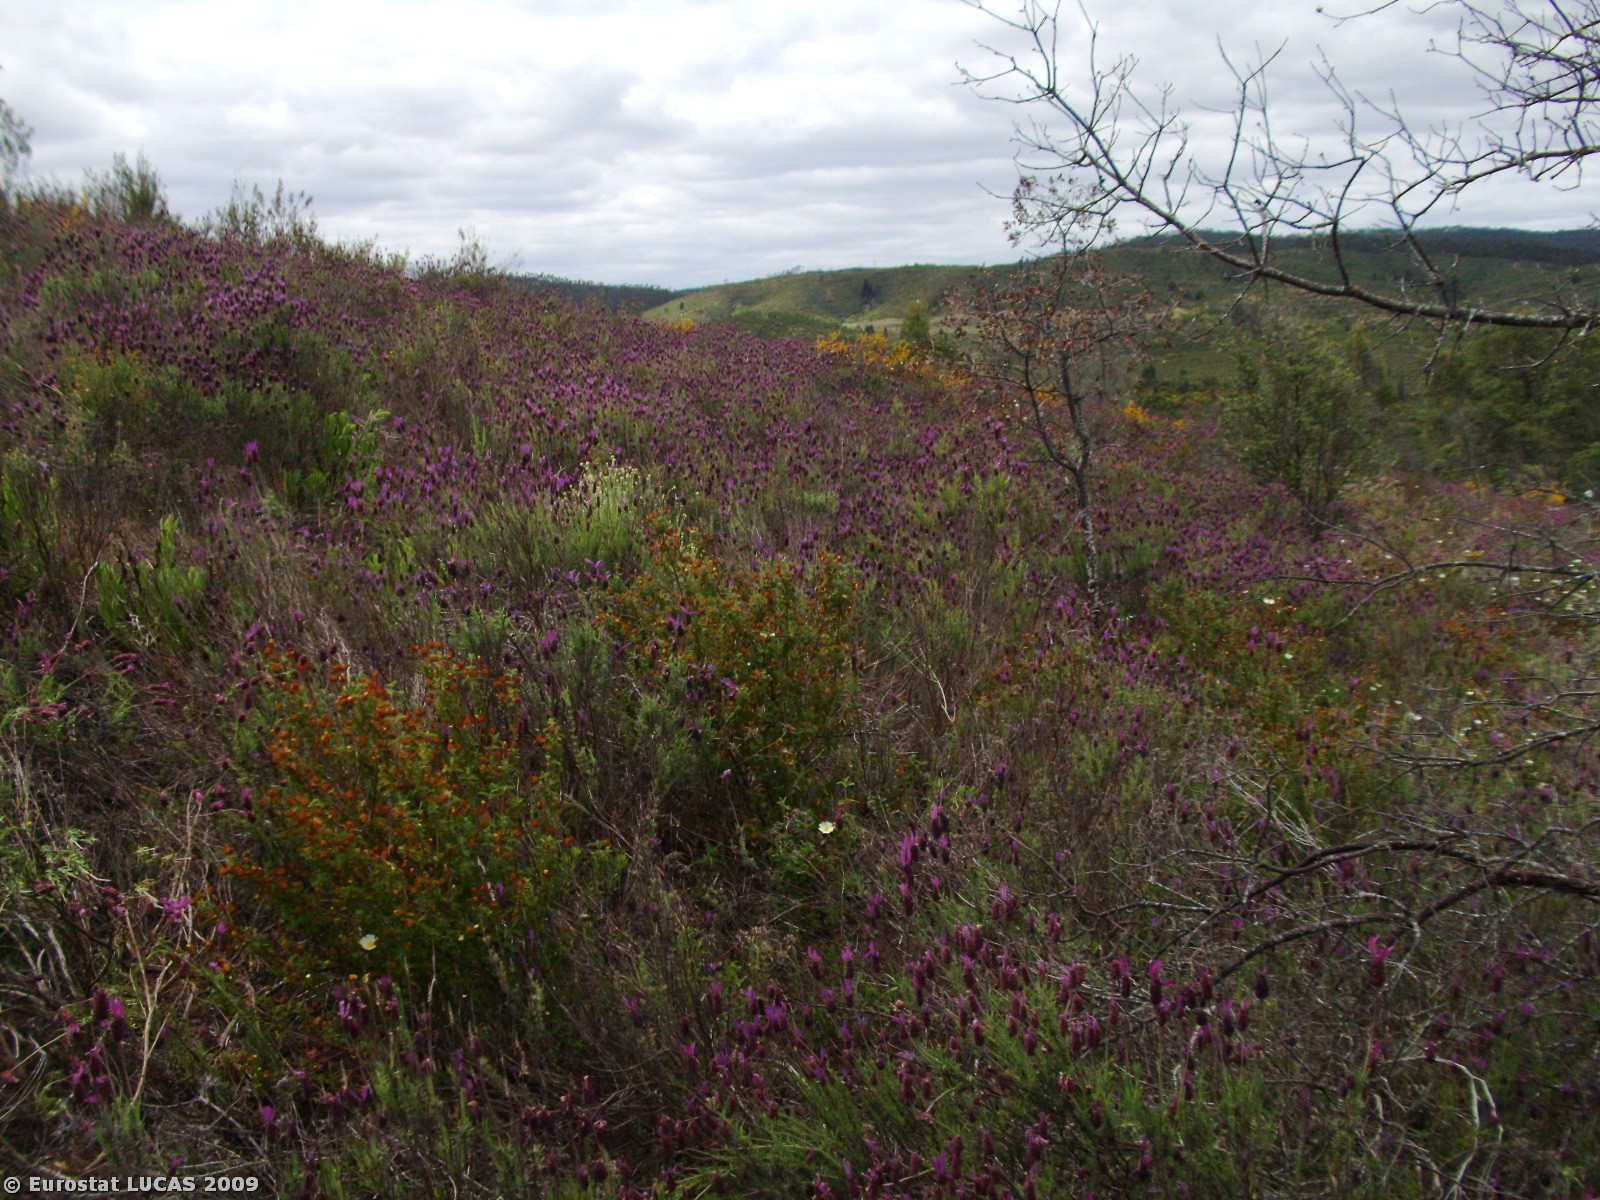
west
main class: Shrubland
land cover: Shrubland with sparse tree cover
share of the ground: > 75 %
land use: Nature reserves
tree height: > 5 m
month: April
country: PT
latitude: 39.7597
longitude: -7.4539
